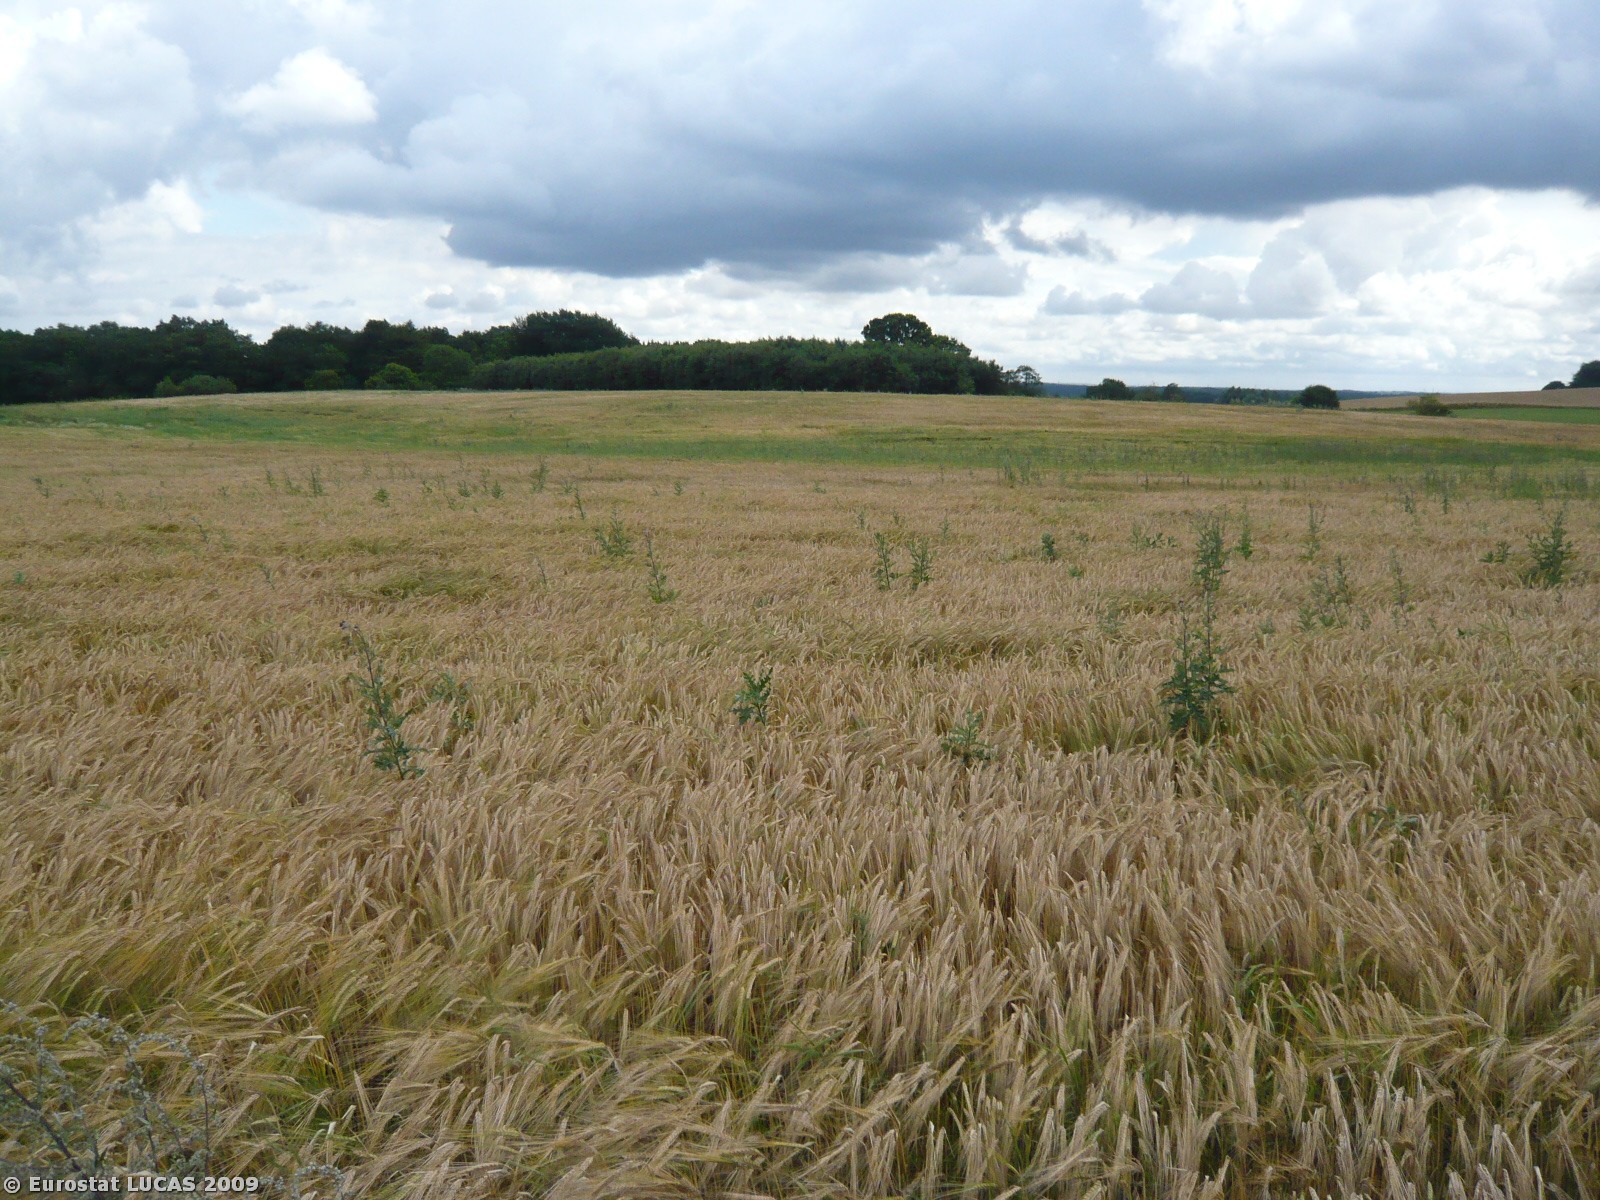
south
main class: Cropland
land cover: Barley
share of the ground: > 75 %
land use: Agriculture (excluding fallow land and kitchen gardens)
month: July
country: DK
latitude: 55.5082
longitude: 11.9143
